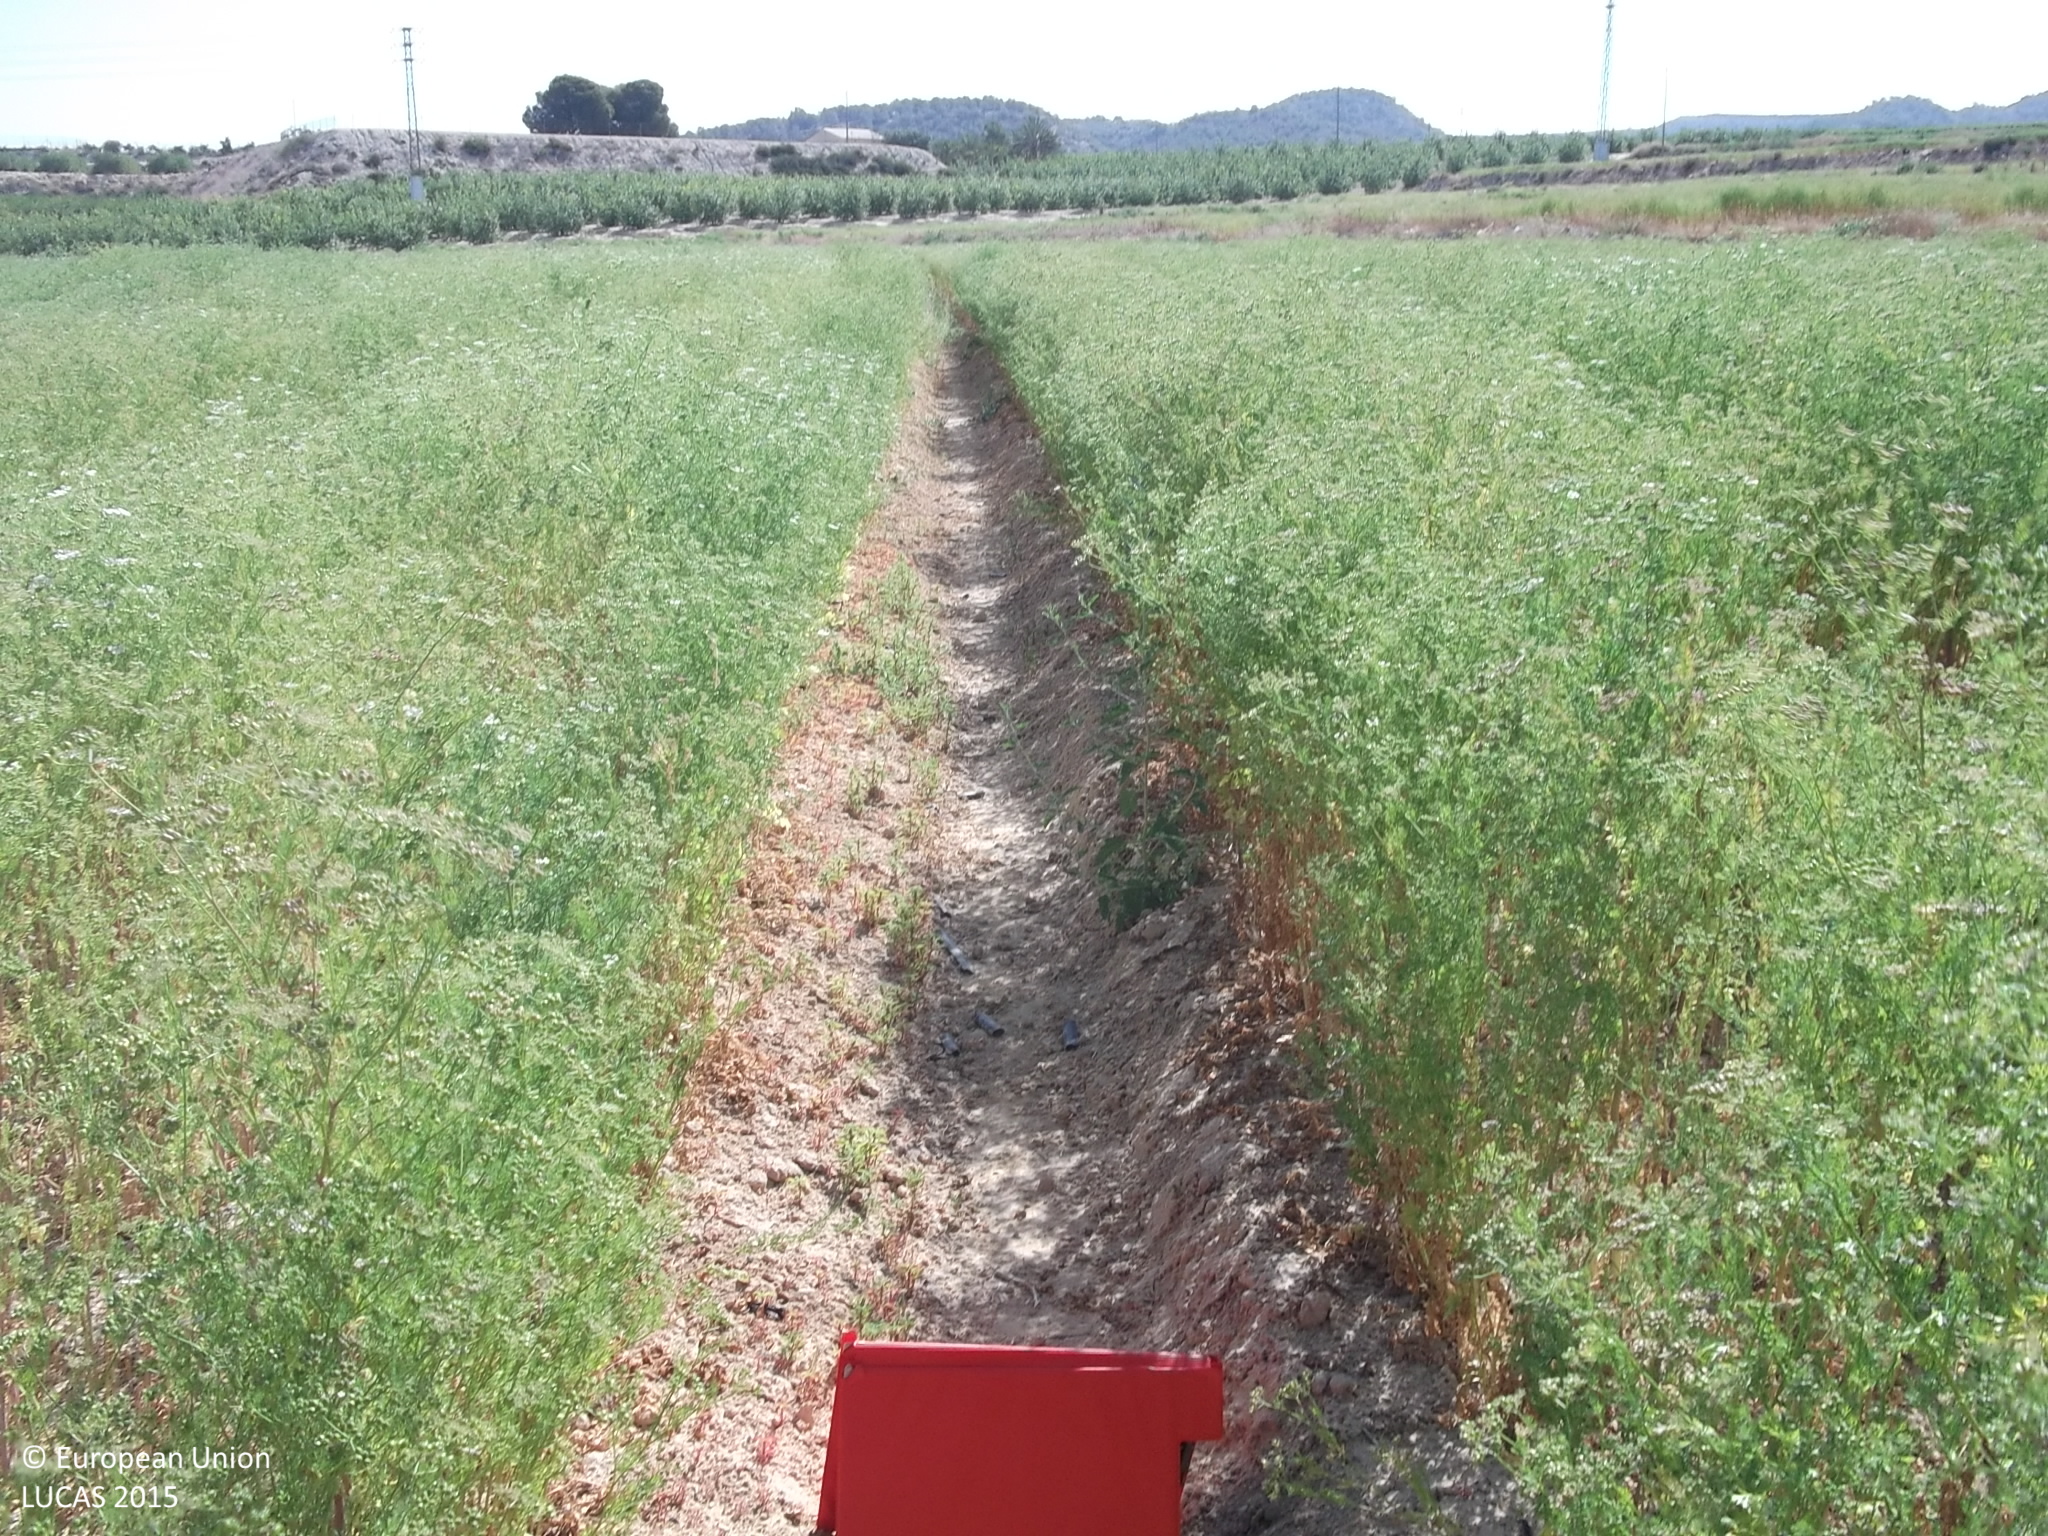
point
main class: Cropland
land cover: Other non-permanent industrial crops
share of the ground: > 75 %
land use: Agriculture (excluding fallow land and kitchen gardens)
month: May
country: ES
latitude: 38.0577
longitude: -0.8447
